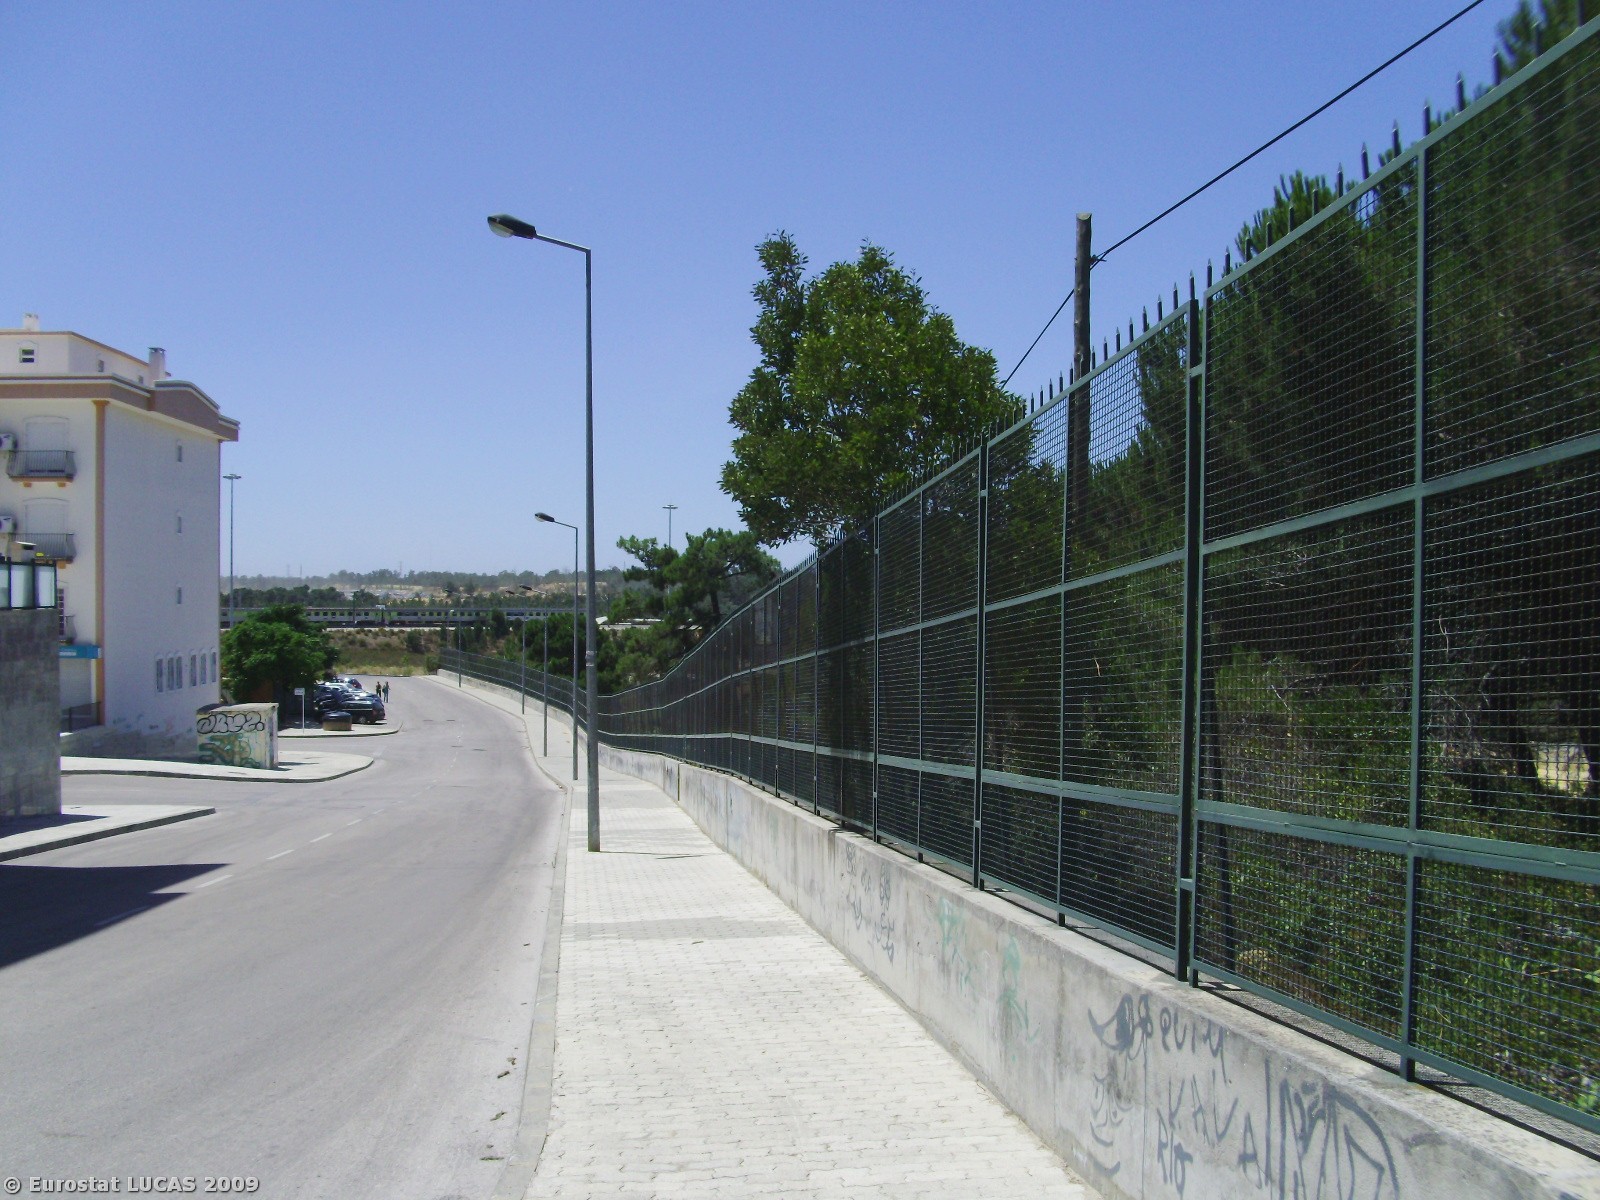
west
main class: Woodland
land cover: Coniferous woodland
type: coniferous forest of the mediterranean region
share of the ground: 25 - 50 %
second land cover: Shrubland with sparse tree cover
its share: 50 - 75 %
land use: Forestry
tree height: > 5 m
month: July
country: PT
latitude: 38.6247
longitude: -9.1285
